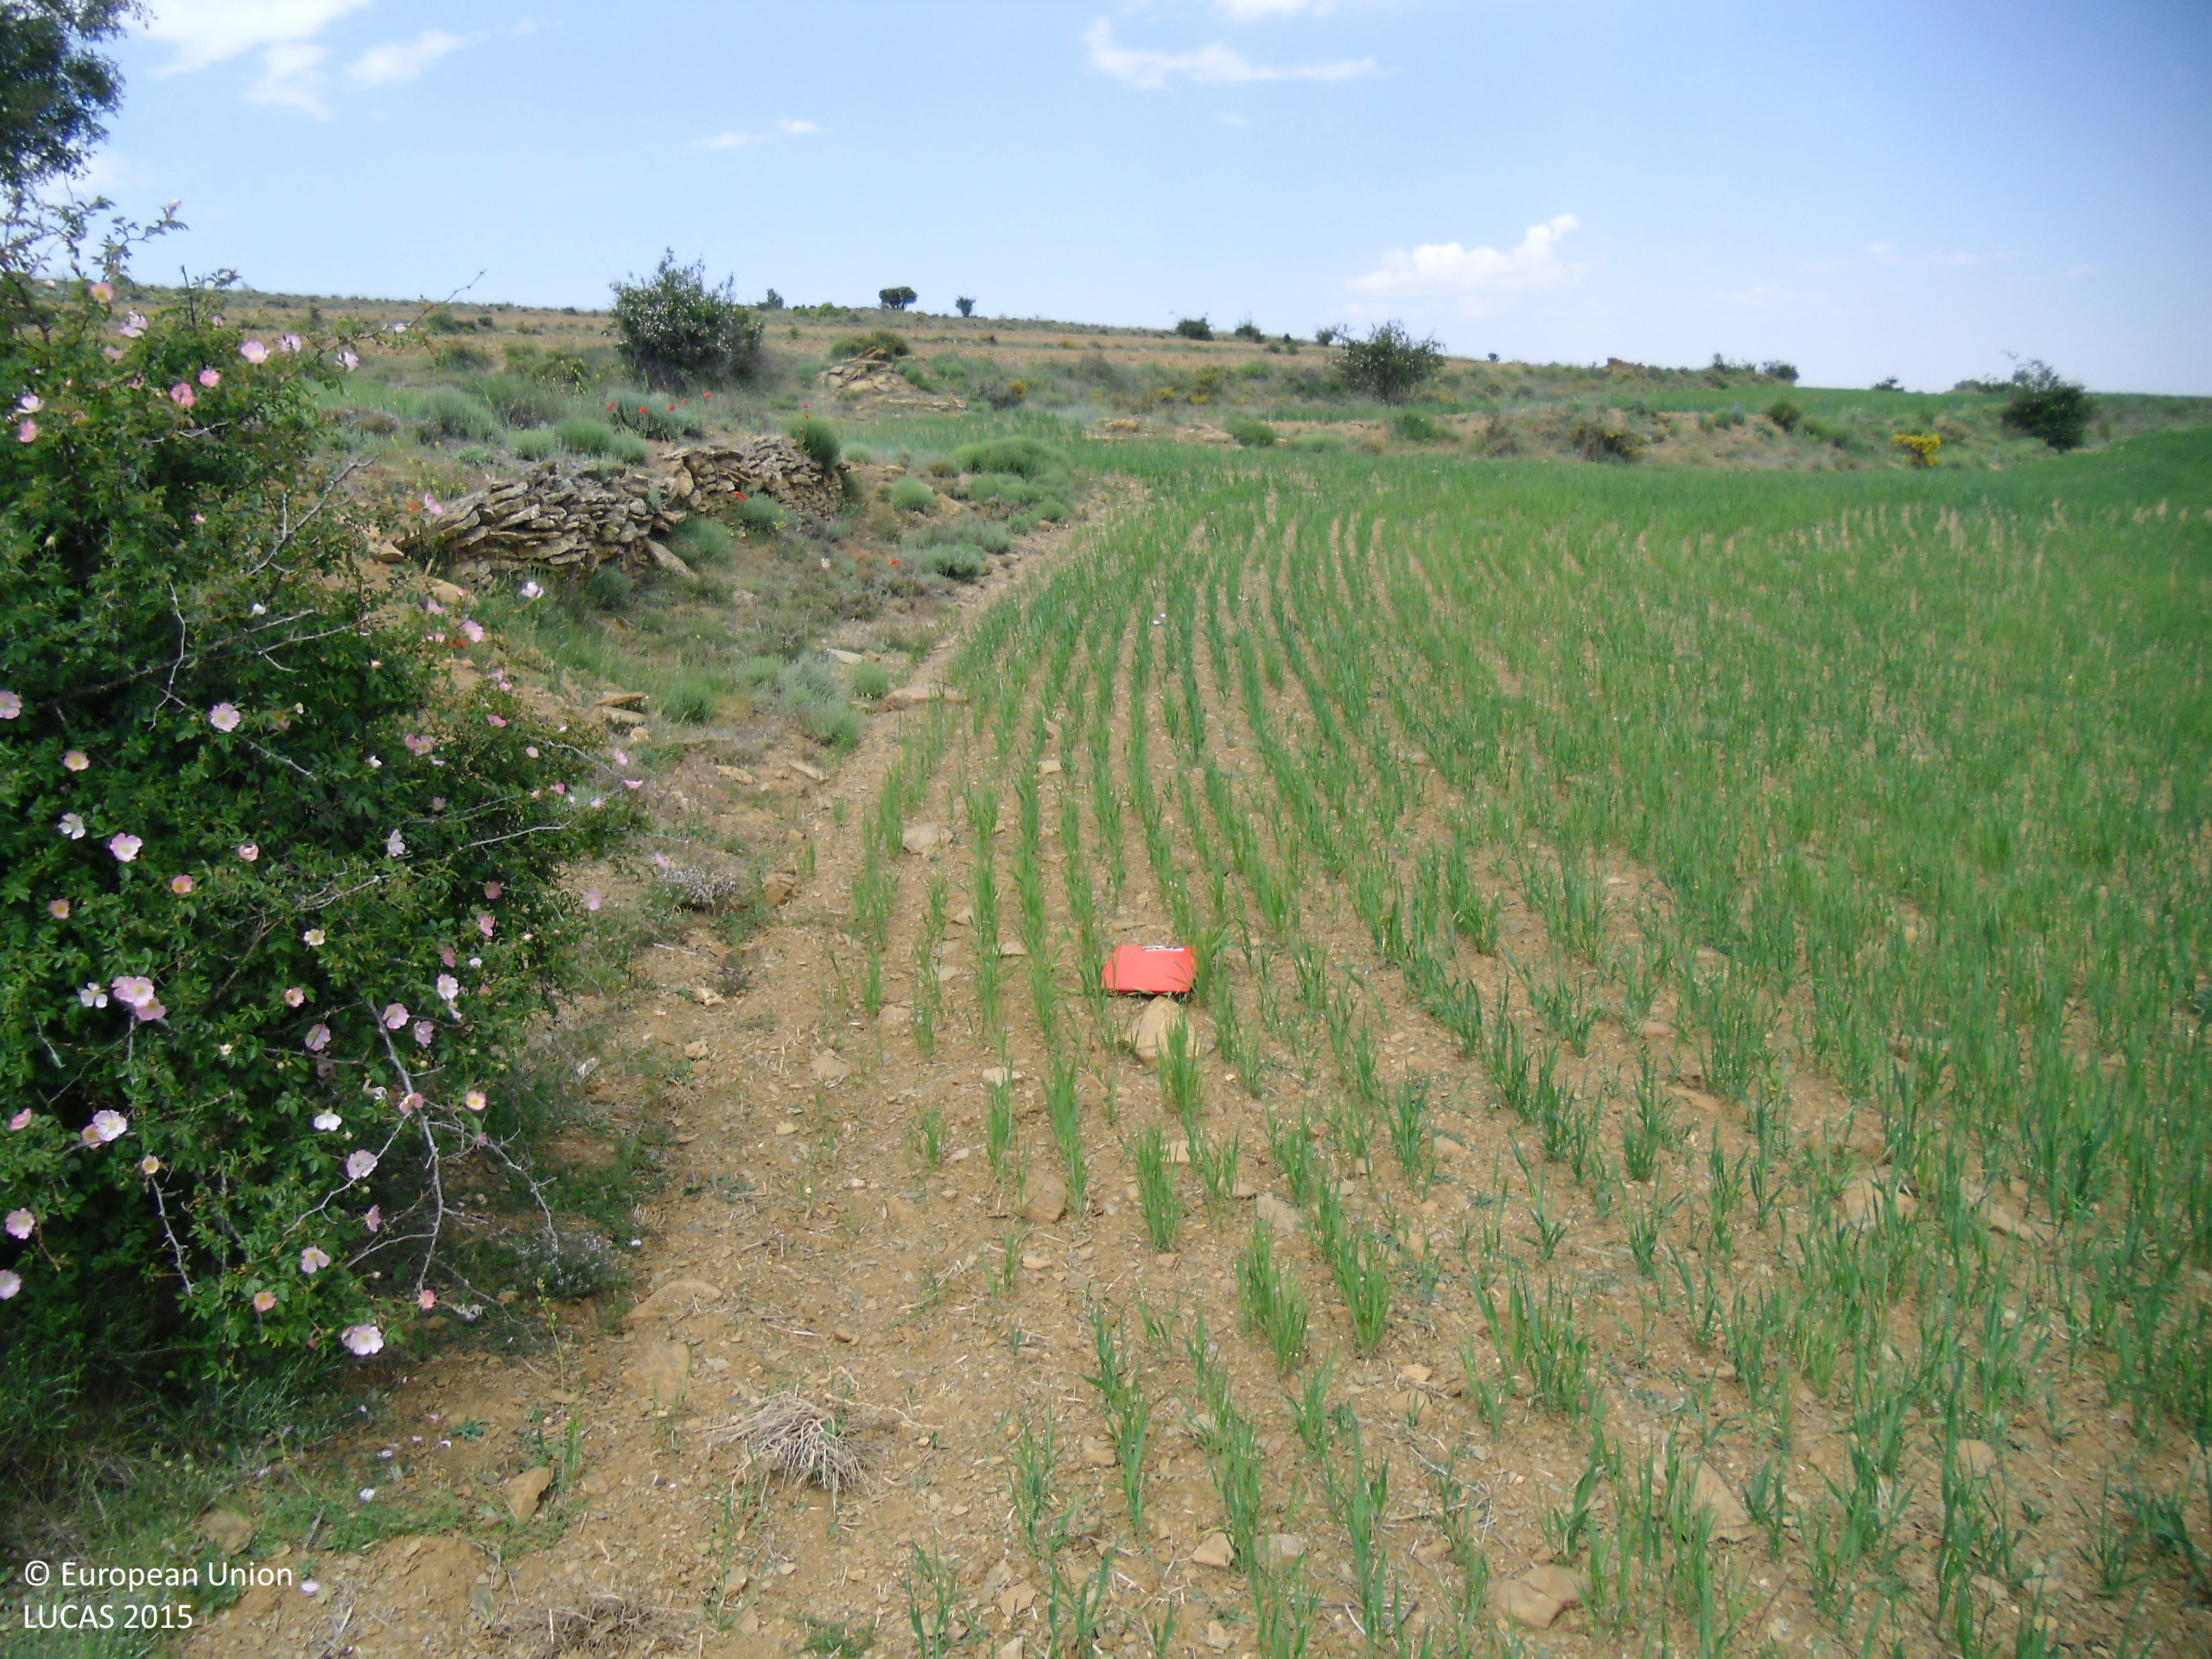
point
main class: Cropland
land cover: Barley
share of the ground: > 75 %
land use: Agriculture (excluding fallow land and kitchen gardens)
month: May
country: ES
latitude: 40.8880
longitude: -0.8263
